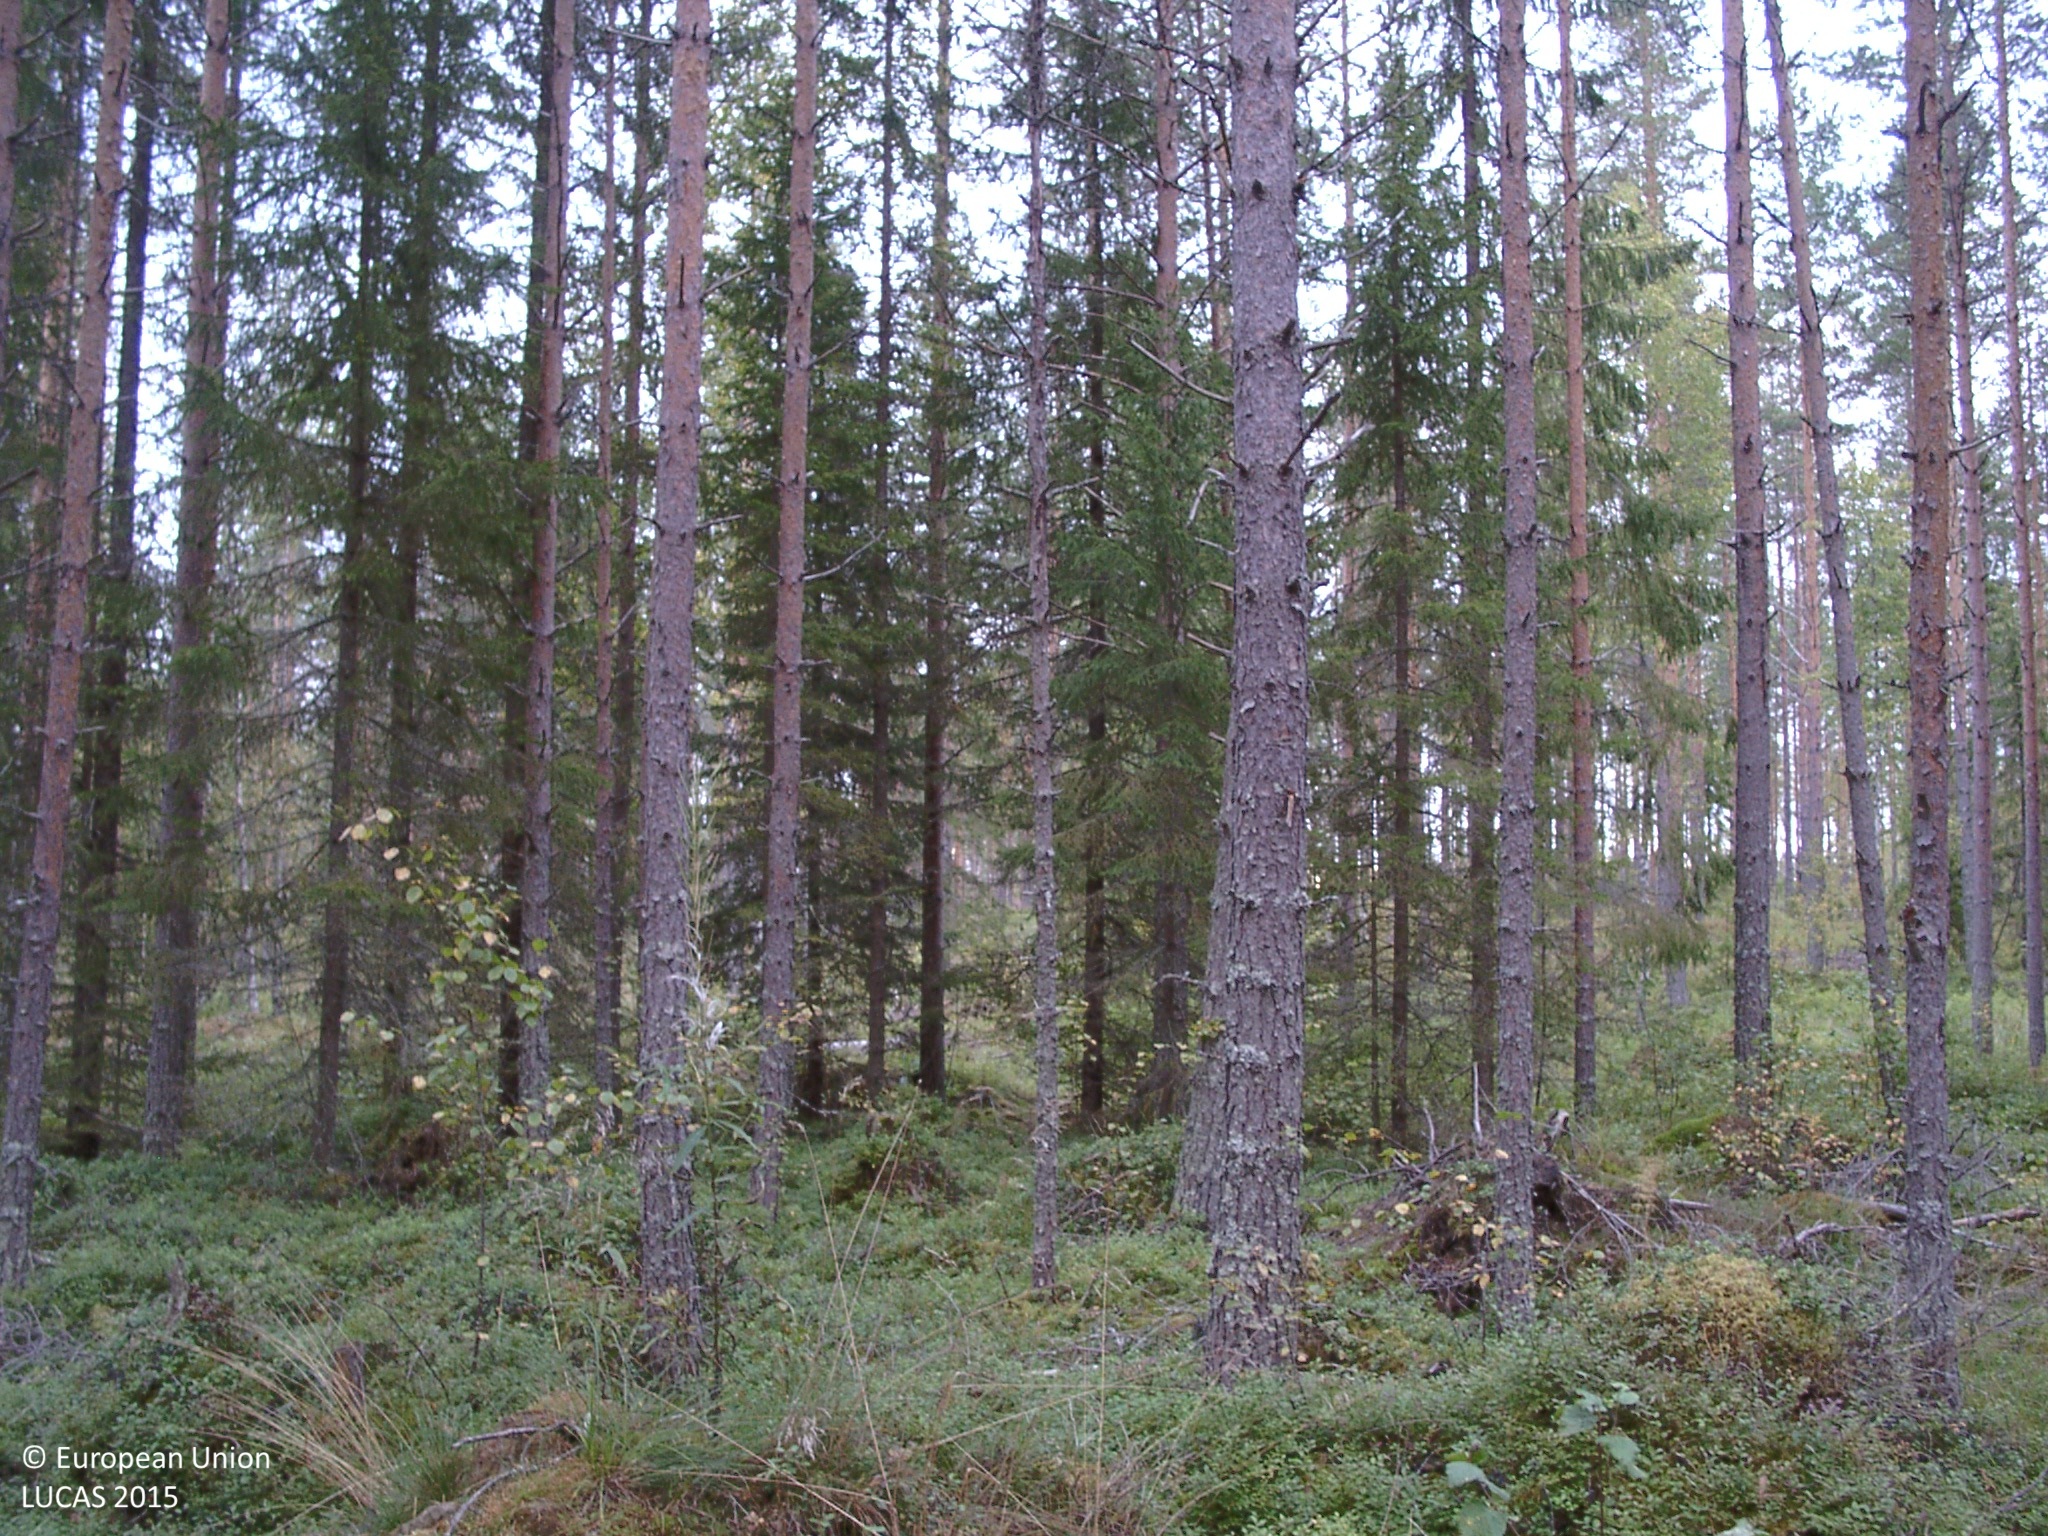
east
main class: Woodland
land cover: Other coniferous woodland
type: boreal forest
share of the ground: 50 - 75 %
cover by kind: coniferous forest trees 60 %, shrubs 20 %, lichens and mosses 10 %, broadleaved forest trees 5 %, unconsolidated bare surface 5 %
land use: Forestry
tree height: > 5 m
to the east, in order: Other coniferous woodland; Other mixed woodland; Ditches and canals; Groves; Tracks; Pine dominated coniferous woodland; Tracks; Pine dominated coniferous woodland; Tracks; Pine dominated coniferous woodland; Tracks; Pine dominated coniferous woodland; Ditches and canals; Tracks; Other coniferous woodland; Tracks; Pine dominated coniferous woodland; Tracks; Pine dominated coniferous woodland; Tracks; Pine dominated coniferous woodland; Shrubland without tree cover; Pine dominated coniferous woodland; Tracks; Pine dominated coniferous woodland
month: September
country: FI
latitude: 62.8764
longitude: 25.4620
